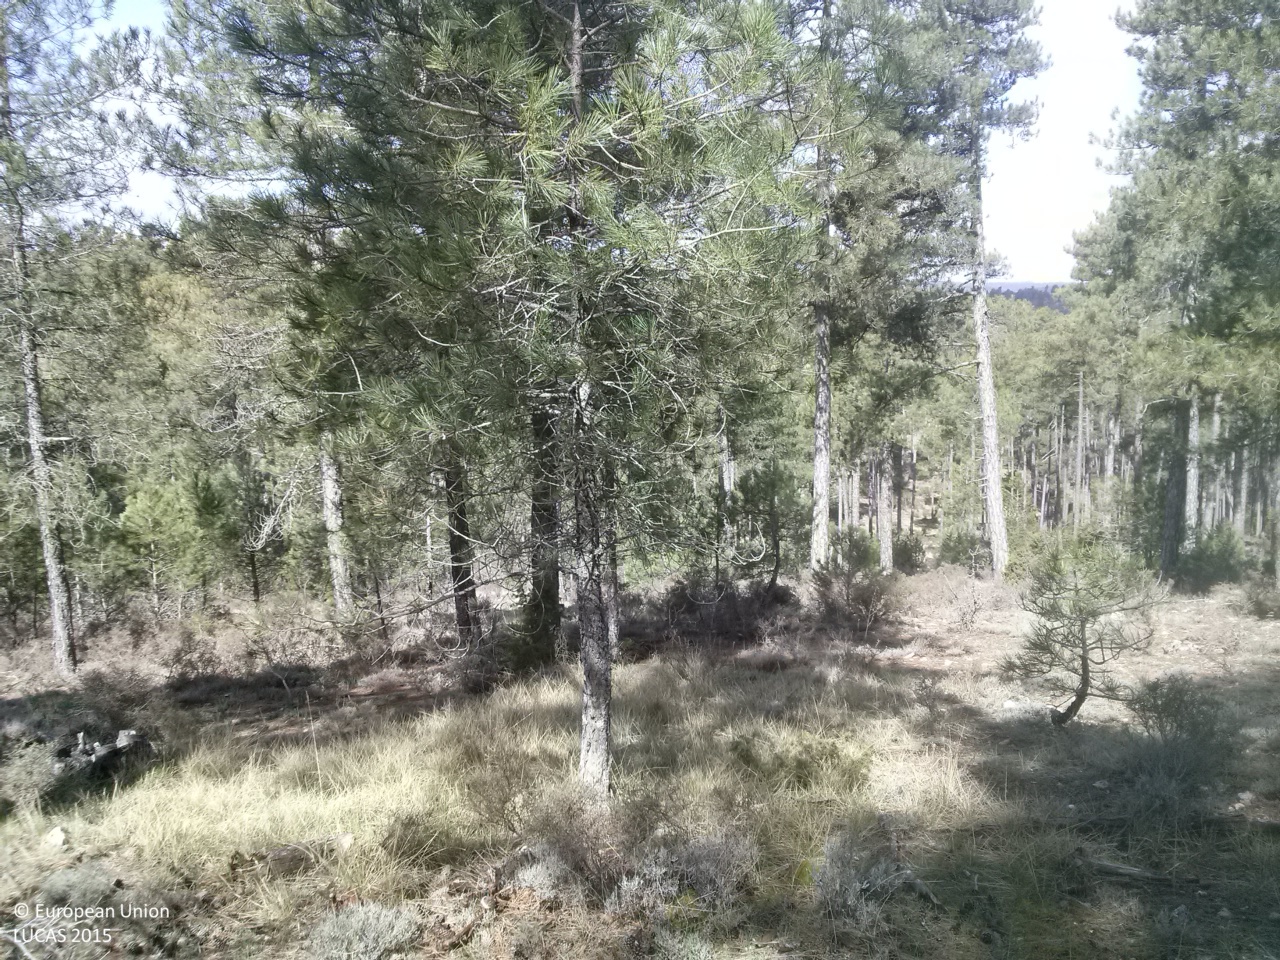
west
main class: Woodland
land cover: Pine dominated coniferous woodland
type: coniferous forest of the mediterranean region
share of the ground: 25 - 50 %
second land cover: Grassland without tree/shrub cover
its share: 50 - 75 %
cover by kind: herbaceous plants 50 %, coniferous forest trees 40 %, shrubs 10 %
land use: Forestry
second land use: Agriculture (excluding fallow land and kitchen gardens)
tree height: > 5 m
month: April
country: ES
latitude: 40.2318
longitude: -1.9216
